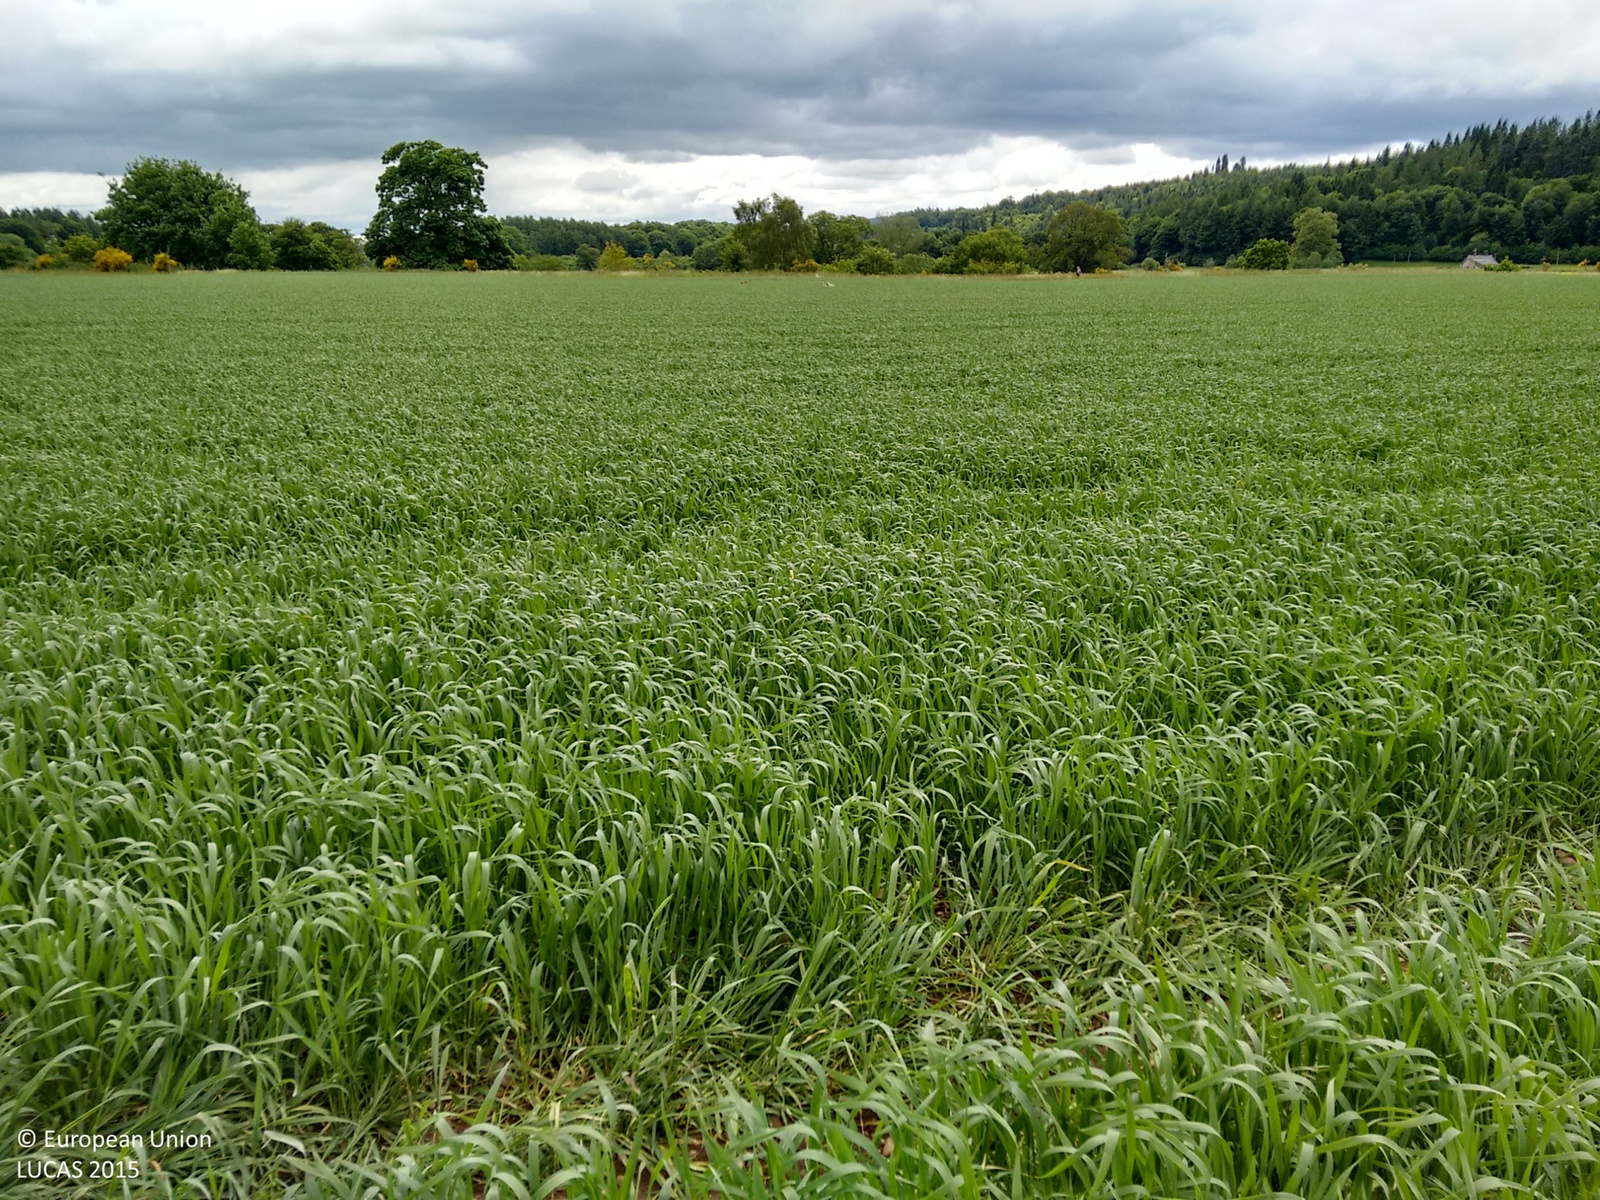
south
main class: Cropland
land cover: Barley
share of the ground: > 75 %
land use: Agriculture (excluding fallow land and kitchen gardens)
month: June
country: GB
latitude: 55.2733
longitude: -3.7955
